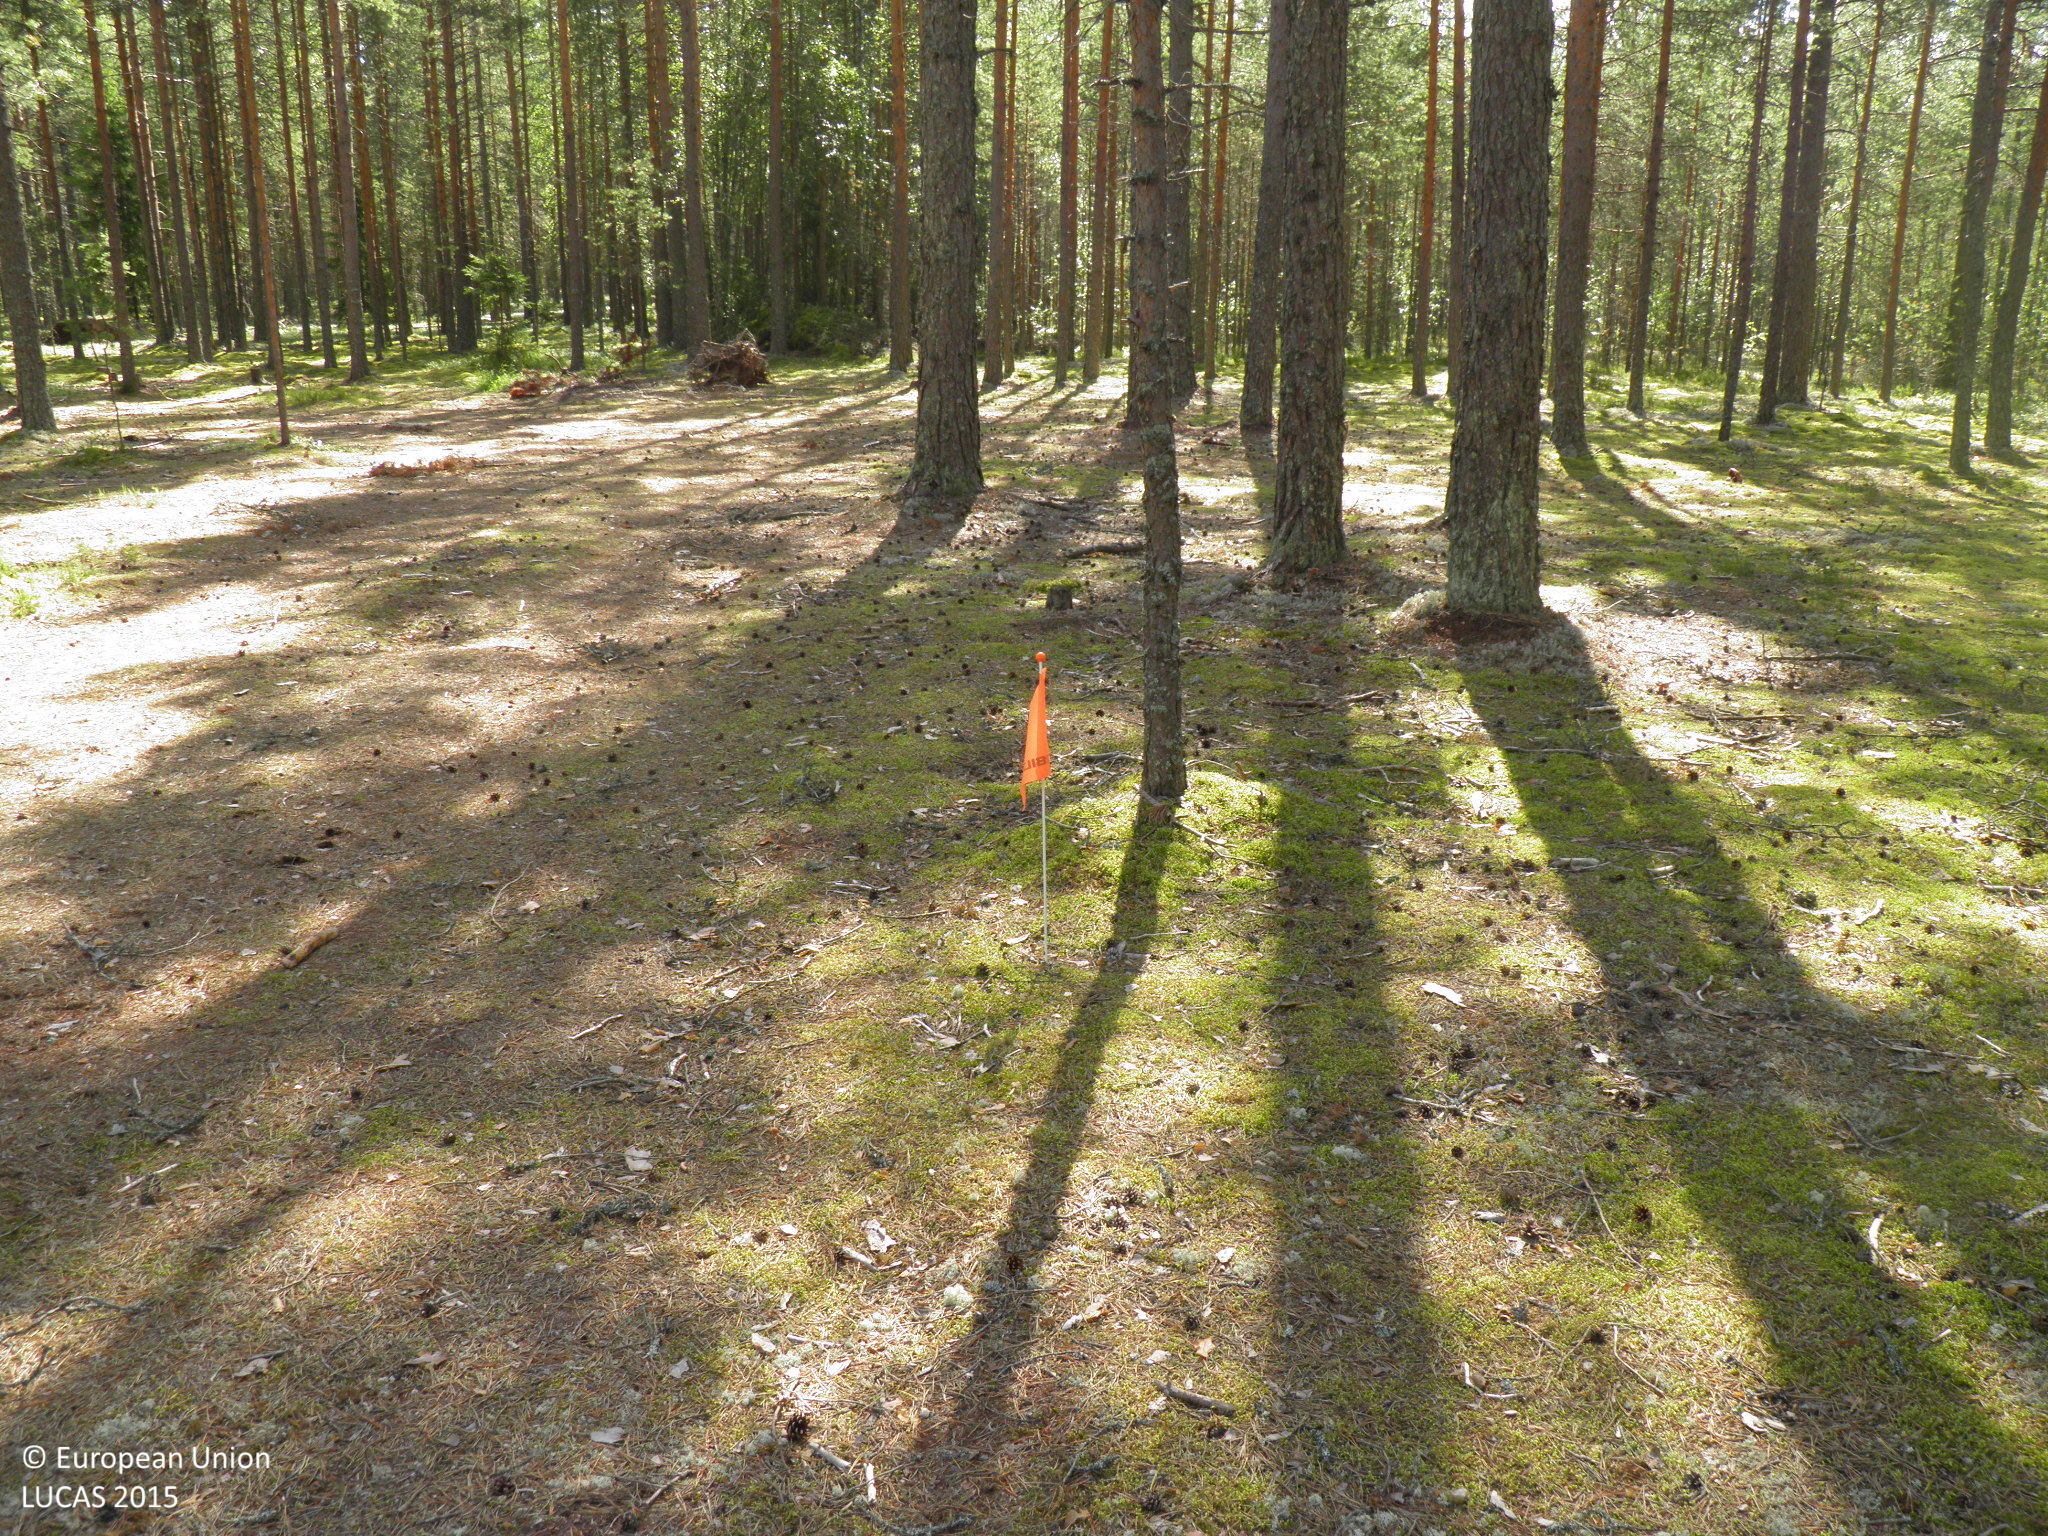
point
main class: Woodland
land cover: Pine dominated coniferous woodland
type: hemiboreal forest and nemoral coniferous forest and mixed broadleaved-coniferous forest
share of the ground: 50 - 75 %
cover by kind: coniferous forest trees 50 %, lichens and mosses 25 %, unconsolidated bare surface 25 %
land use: Forestry
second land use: Amenities, museums, leisure
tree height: > 5 m
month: August
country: FI
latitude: 60.9881
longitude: 22.5443
